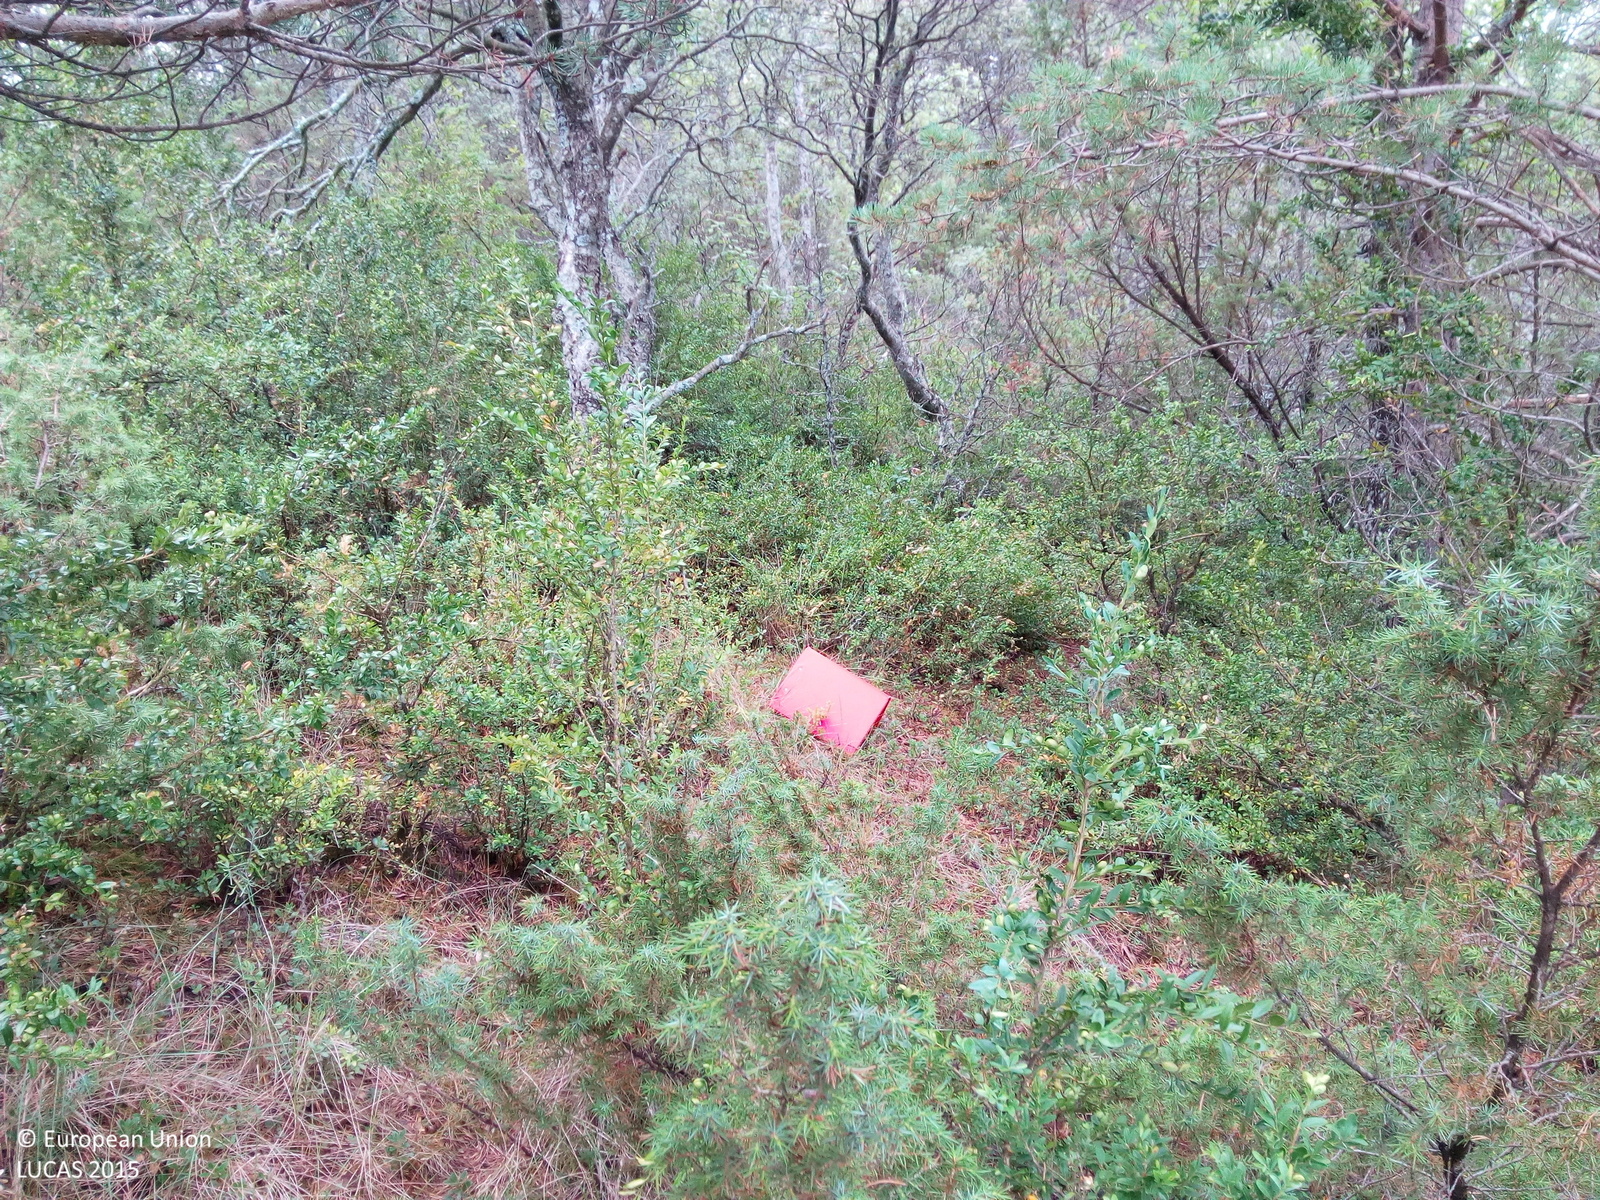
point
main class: Woodland
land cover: Pine dominated mixed woodland
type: coniferous forest of the mediterranean region
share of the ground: > 75 %
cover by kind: broadleaved forest trees 40 %, coniferous forest trees 30 %, shrubs 20 %, herbaceous plants 10 %
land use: Semi-natural and natural areas not in use
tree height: > 5 m
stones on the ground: < 10 %
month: August
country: ES
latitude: 42.1998
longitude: 0.6216
